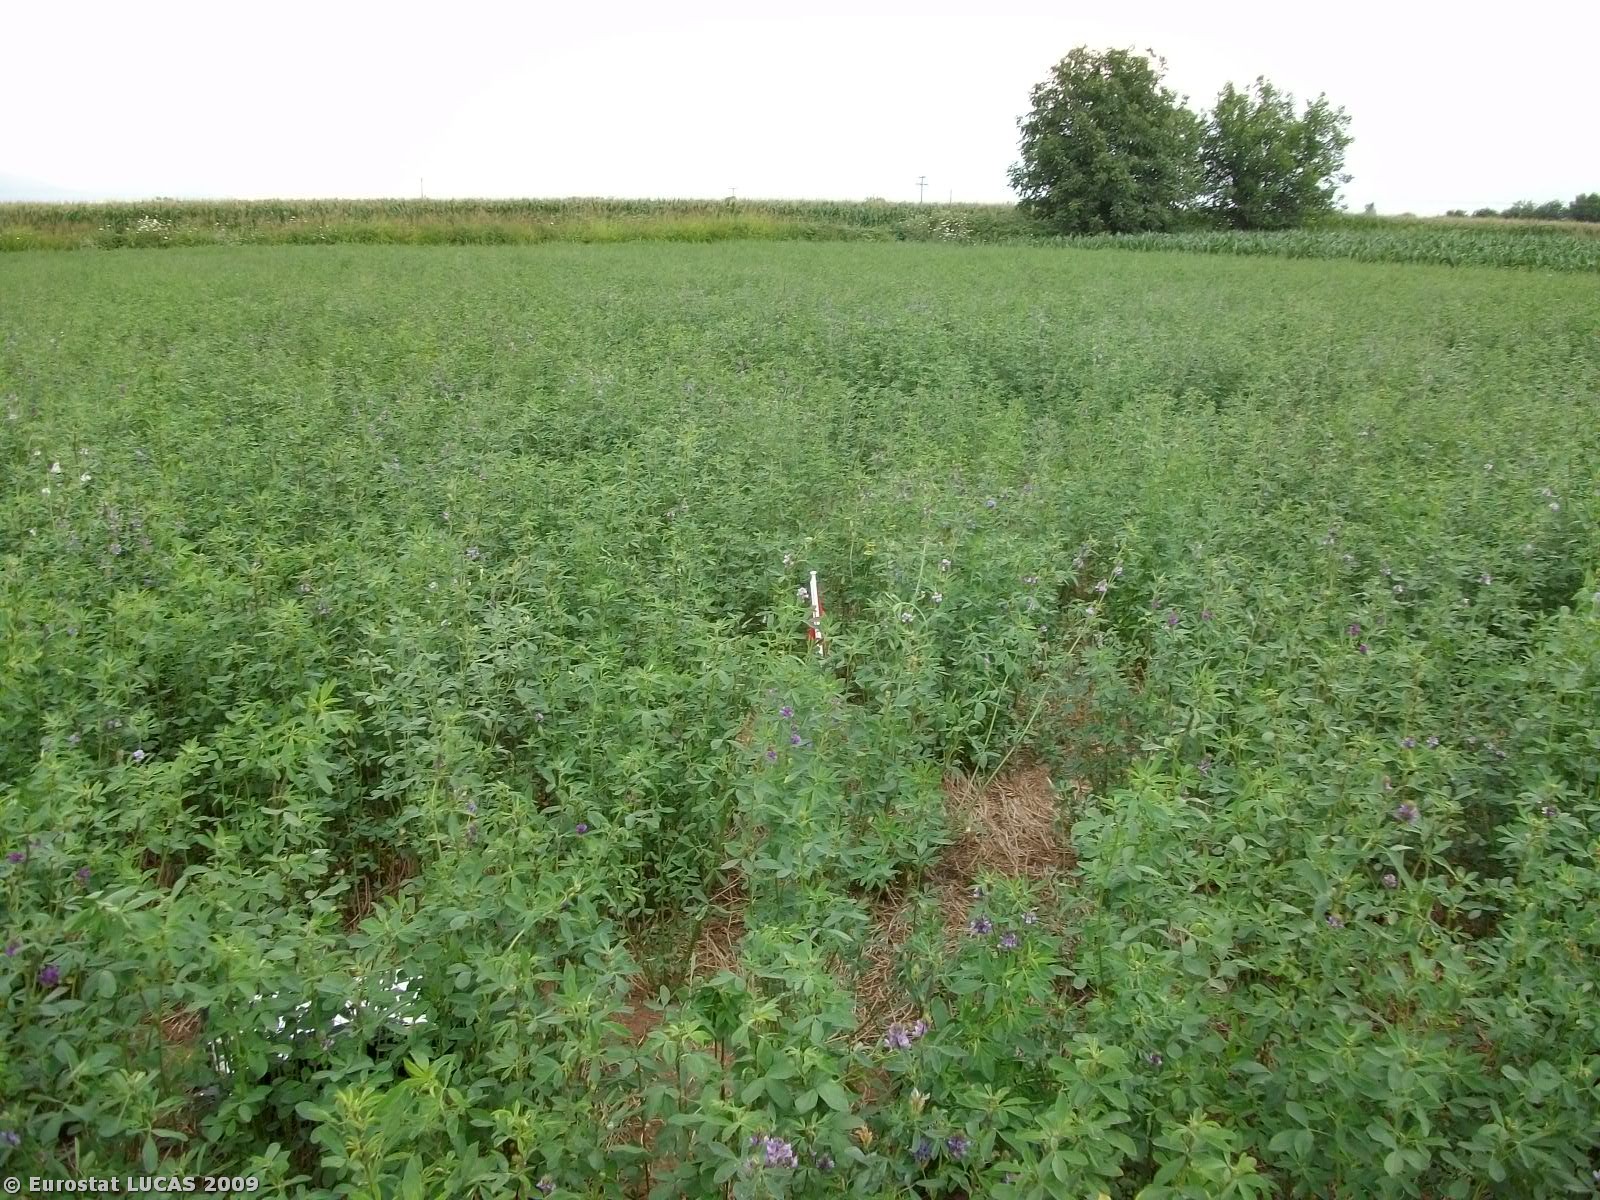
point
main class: Cropland
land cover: Clovers
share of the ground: > 75 %
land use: Agriculture (excluding fallow land and kitchen gardens)
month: July
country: GR
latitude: 39.4927
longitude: 21.6912
